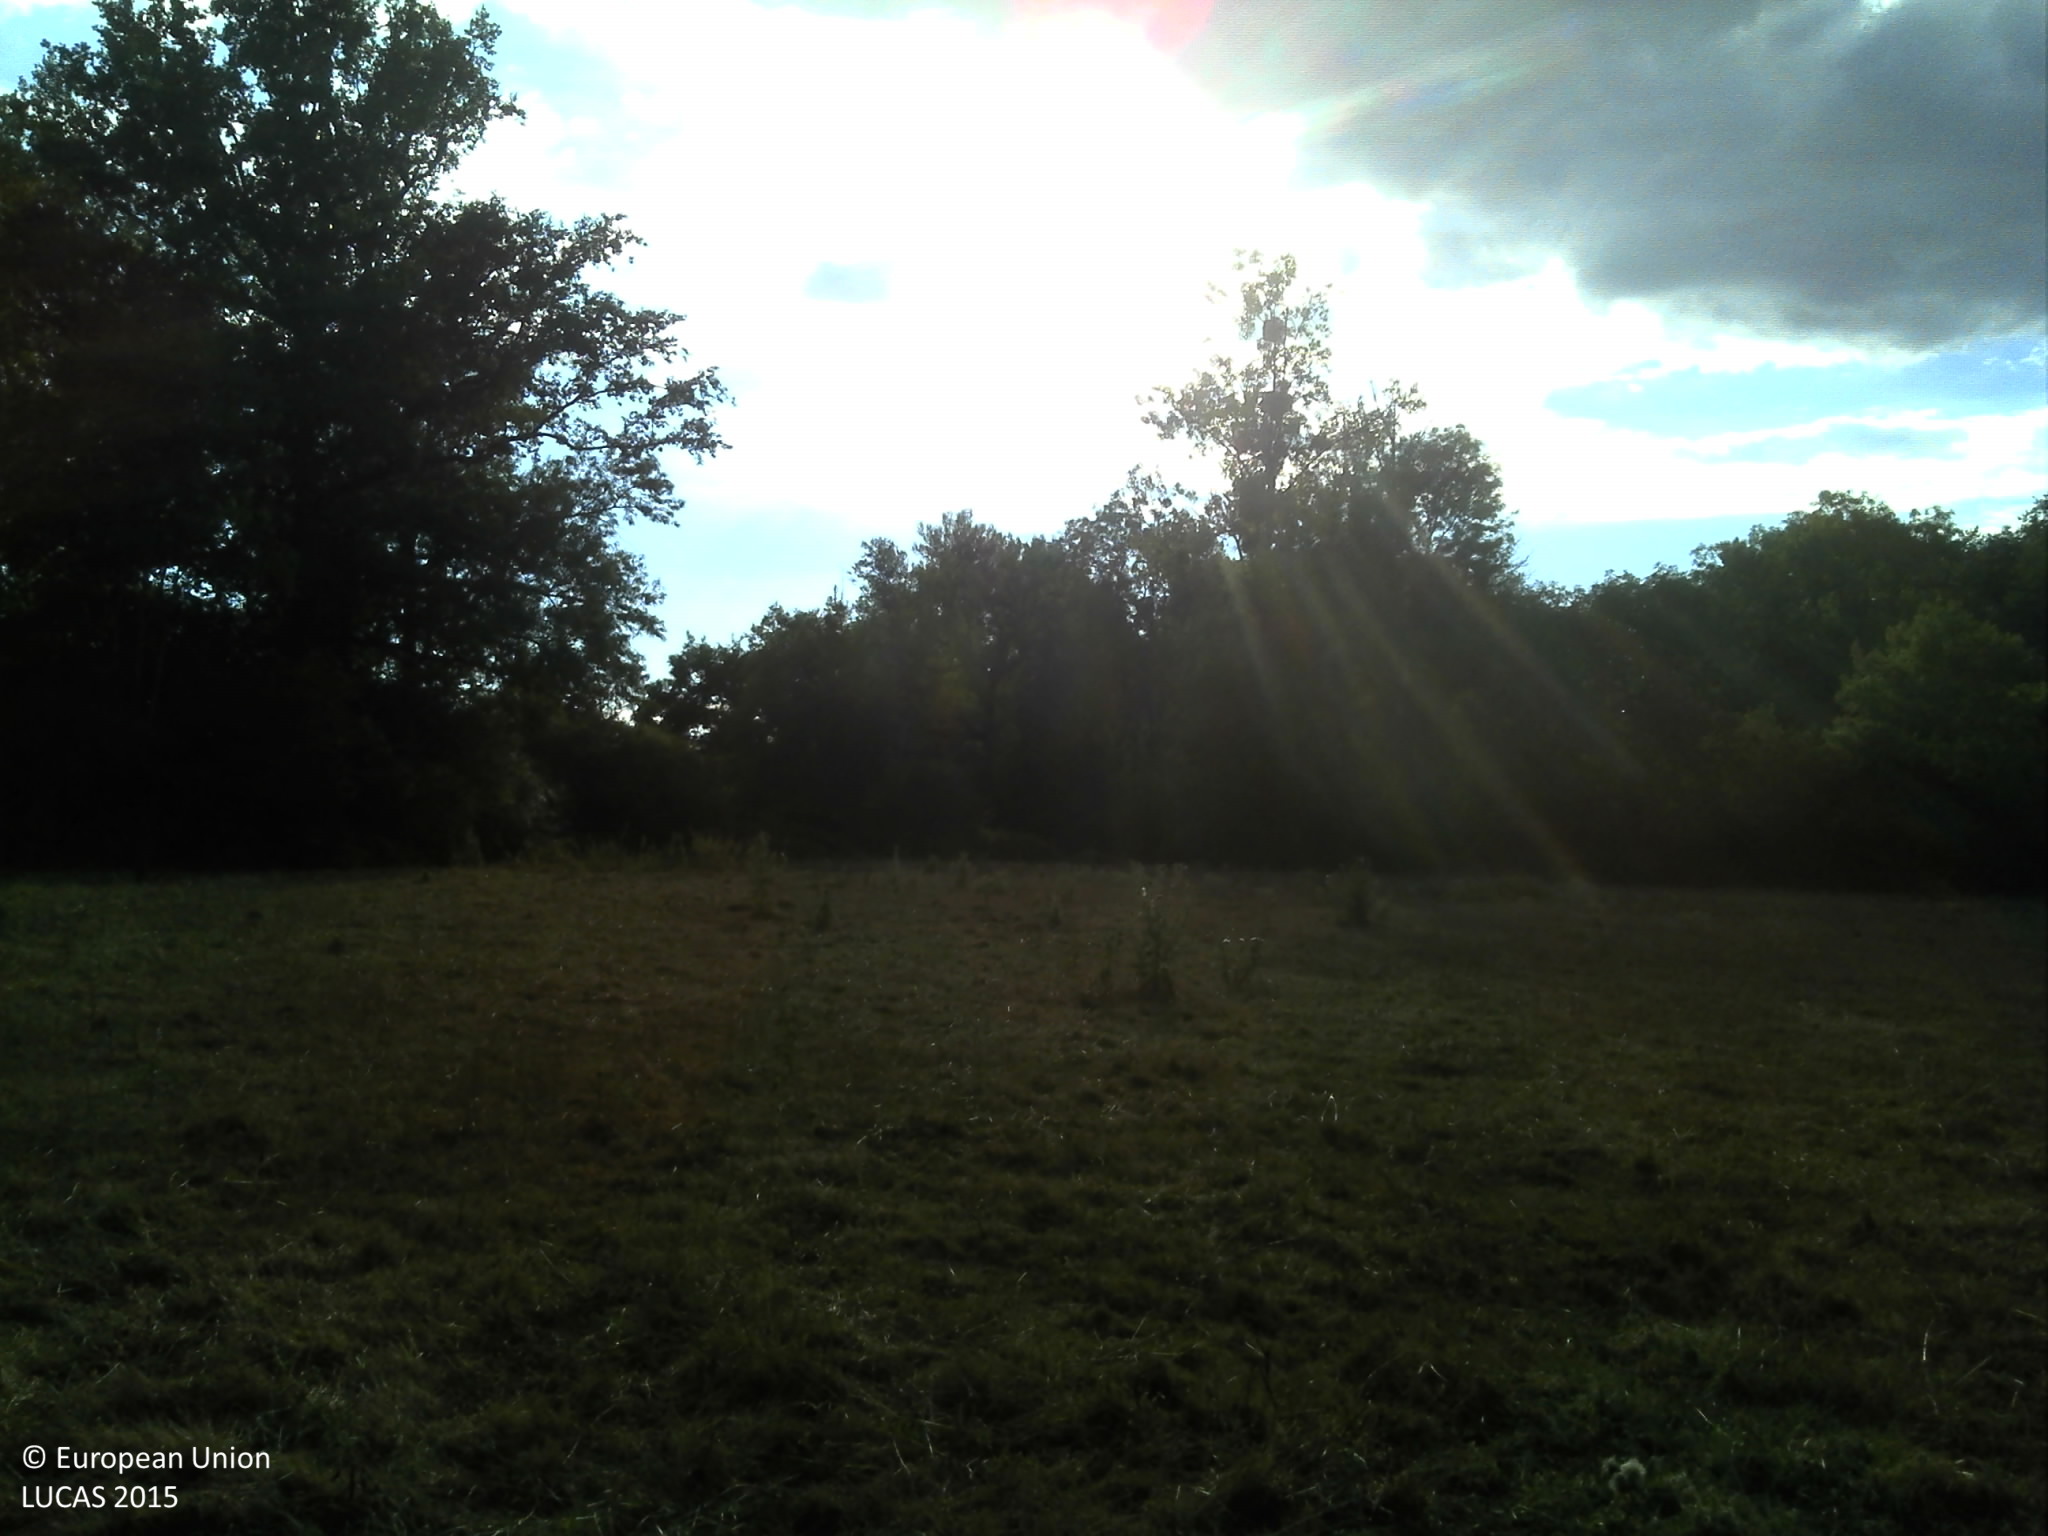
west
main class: Grassland
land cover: Grassland without tree/shrub cover
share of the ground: > 75 %
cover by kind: herbaceous plants 100 %
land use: Agriculture (excluding fallow land and kitchen gardens)
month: July
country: FR
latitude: 45.8282
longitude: 4.1195
